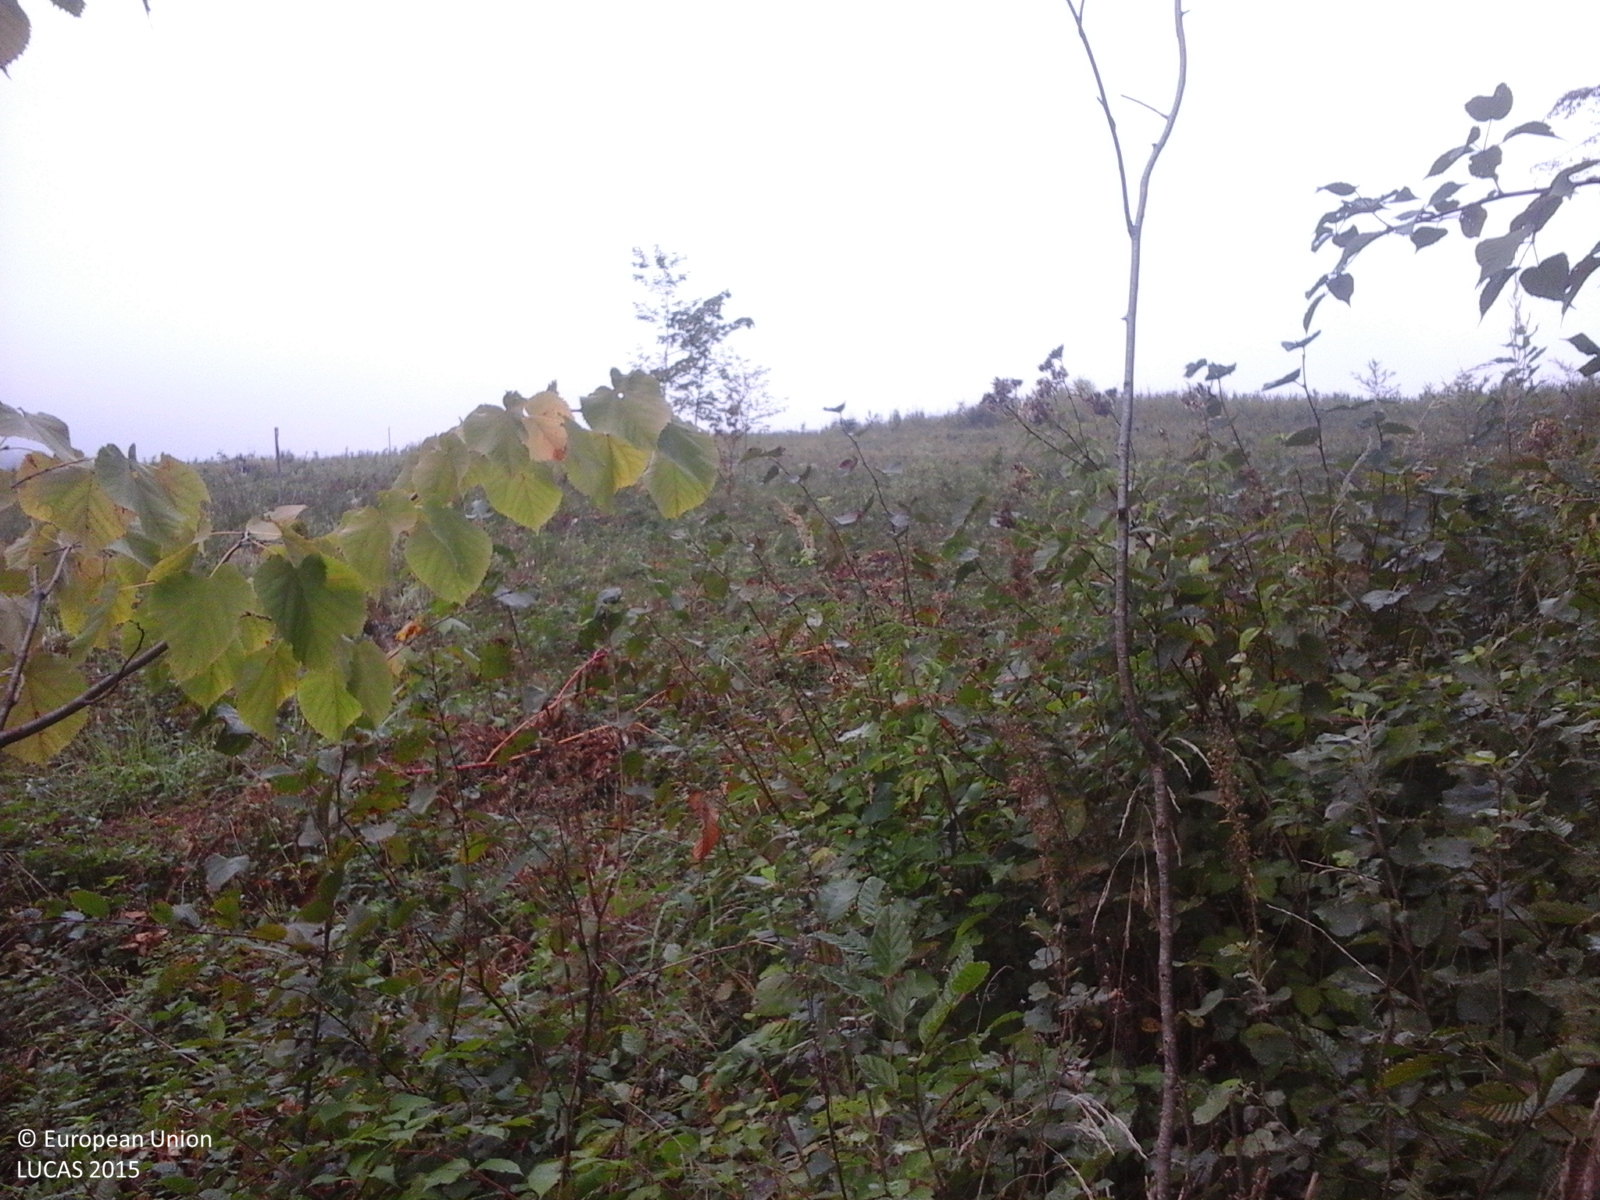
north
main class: Shrubland
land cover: Shrubland without tree cover
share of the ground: > 75 %
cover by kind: shrubs 100 %
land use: Forestry
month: September
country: RO
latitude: 45.7600
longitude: 22.1925
